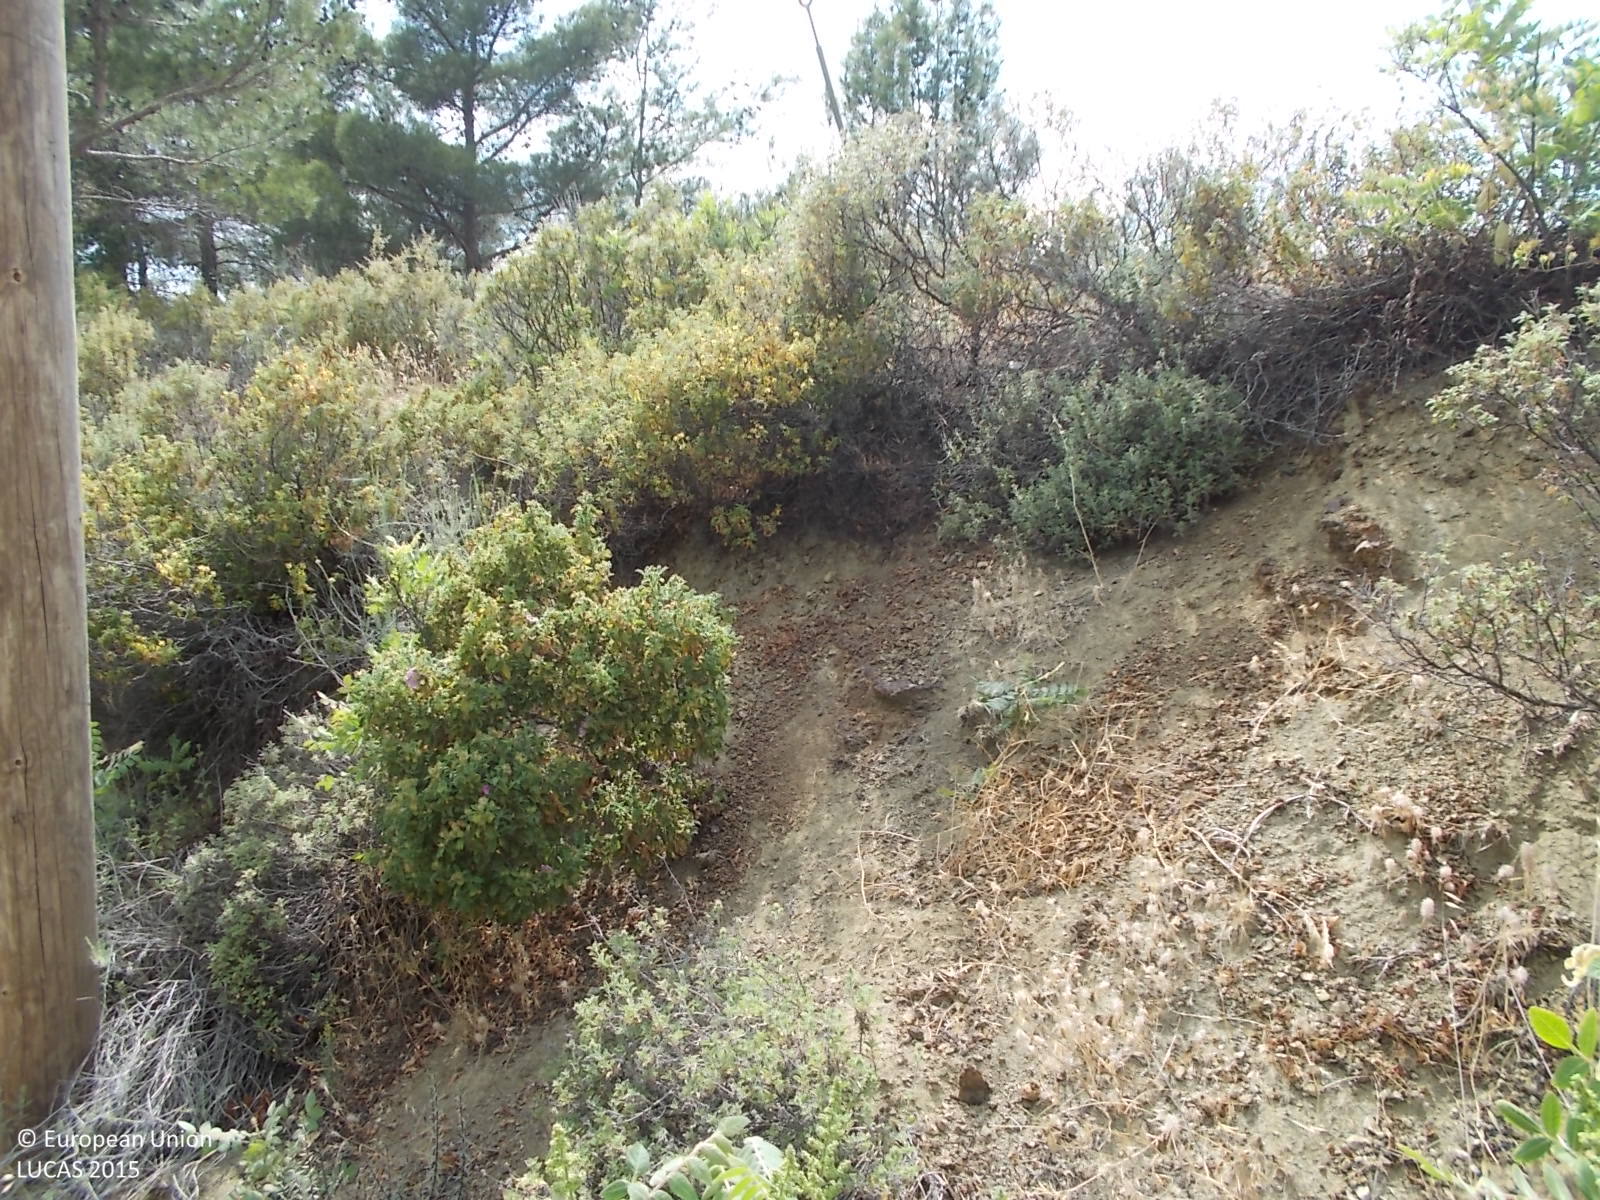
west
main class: Shrubland
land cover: Shrubland with sparse tree cover
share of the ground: 25 - 50 %
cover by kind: unconsolidated bare surface 50 %, shrubs 45 %, coniferous forest trees 5 %
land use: Semi-natural and natural areas not in use
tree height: > 5 m
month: June
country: CY
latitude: 34.8892
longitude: 32.8471
